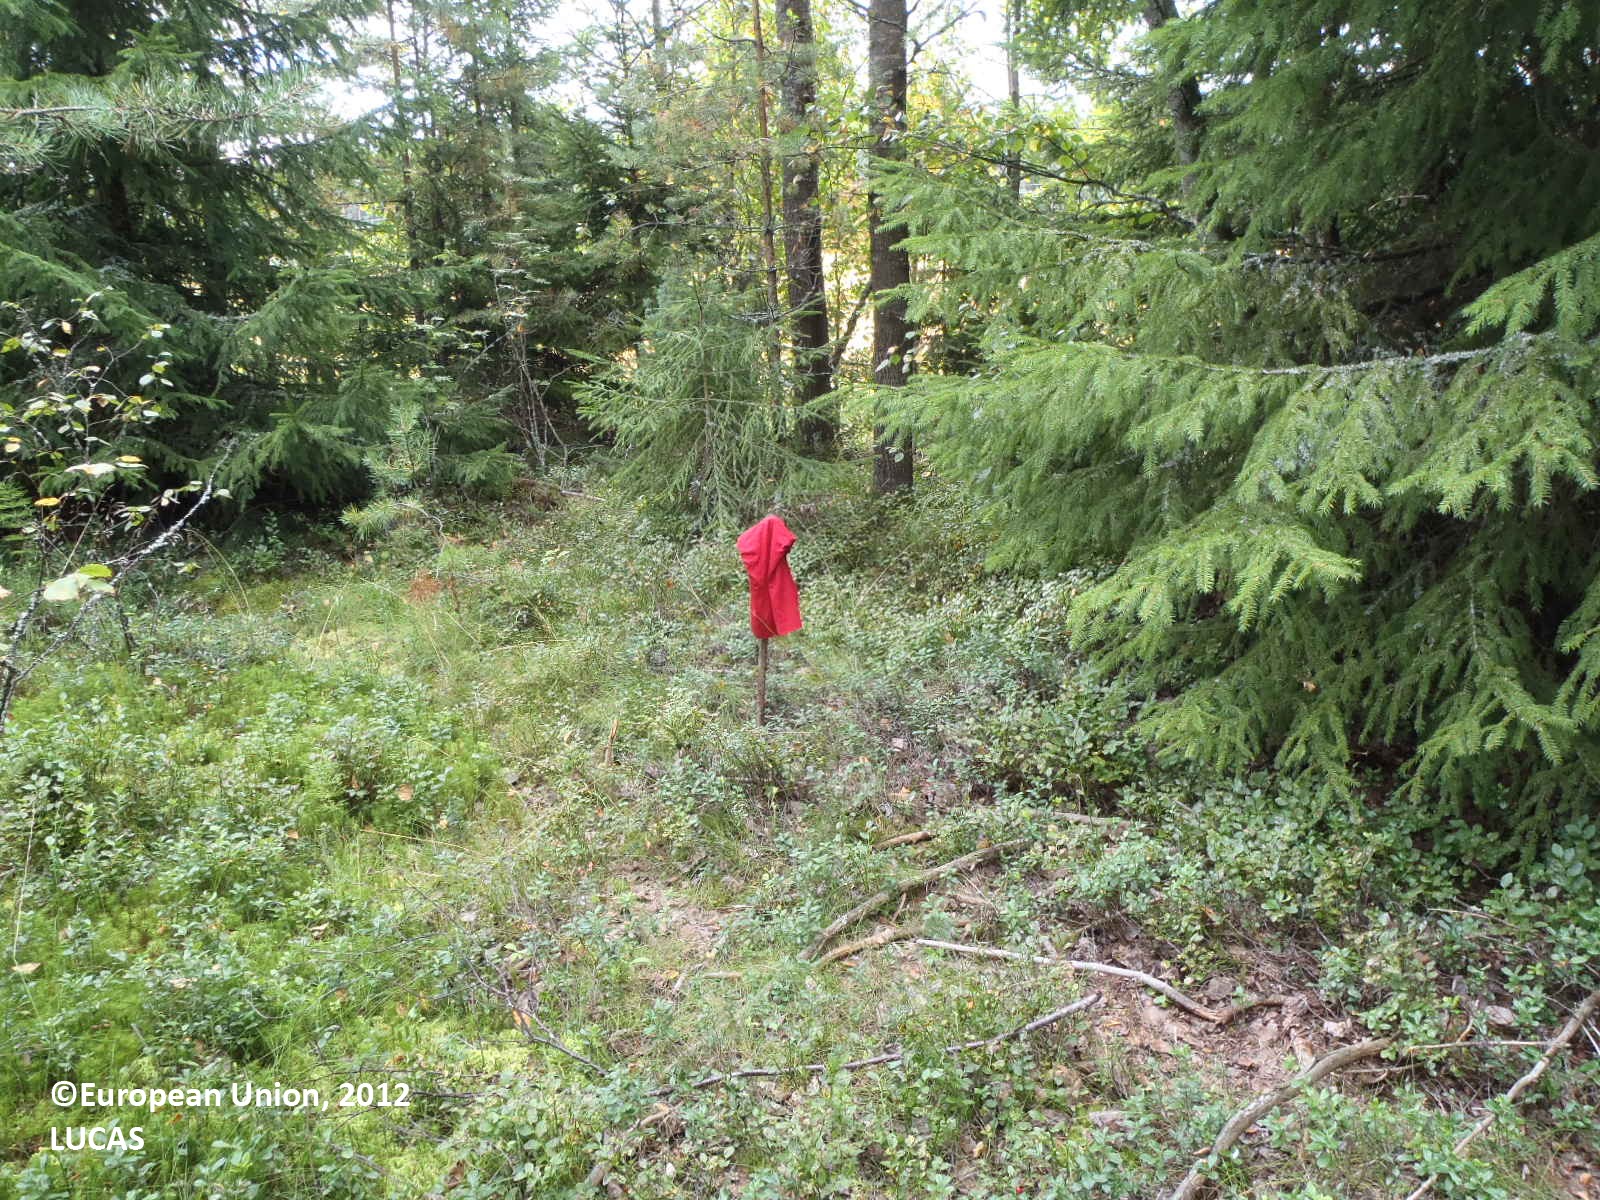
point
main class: Woodland
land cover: Spruce dominated mixed woodland
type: boreal forest
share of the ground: > 75 %
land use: Forestry
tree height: > 5 m
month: August
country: FI
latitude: 60.5316
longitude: 22.3318
